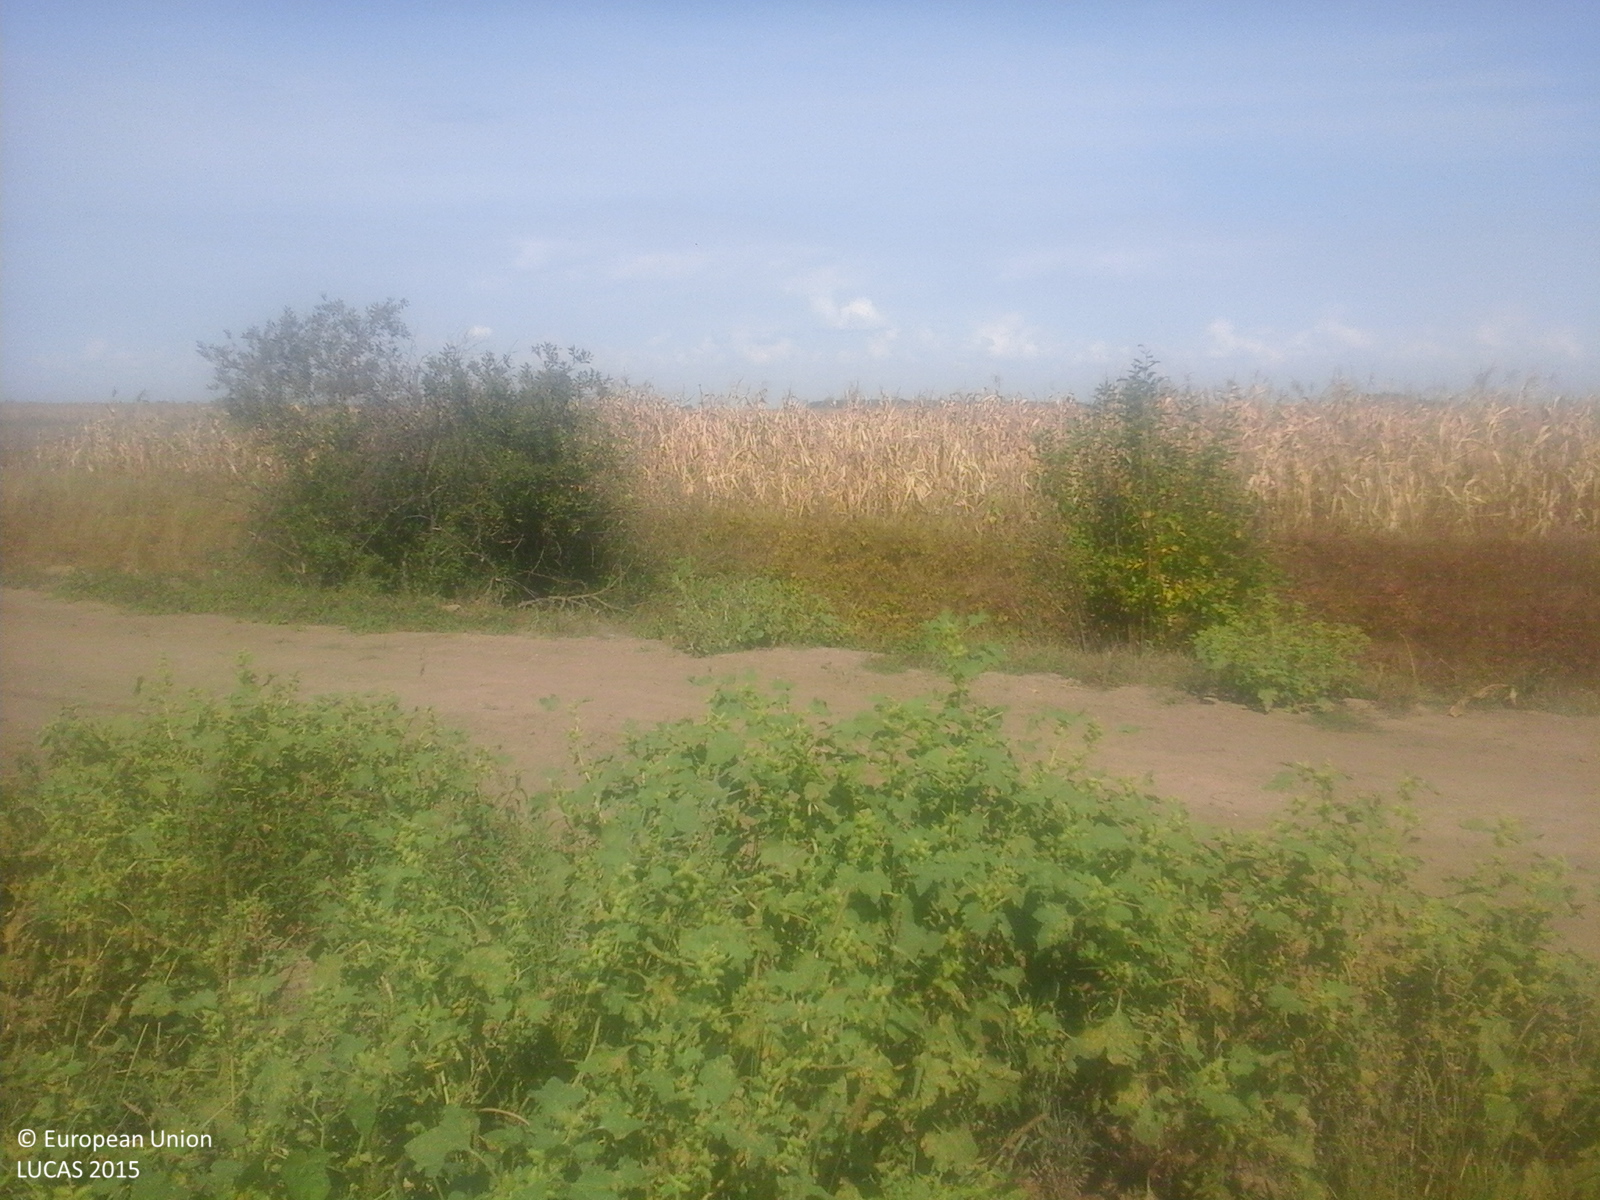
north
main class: Cropland
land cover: Maize
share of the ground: > 75 %
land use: Agriculture (excluding fallow land and kitchen gardens)
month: September
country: RO
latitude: 47.7330
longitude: 22.6073
